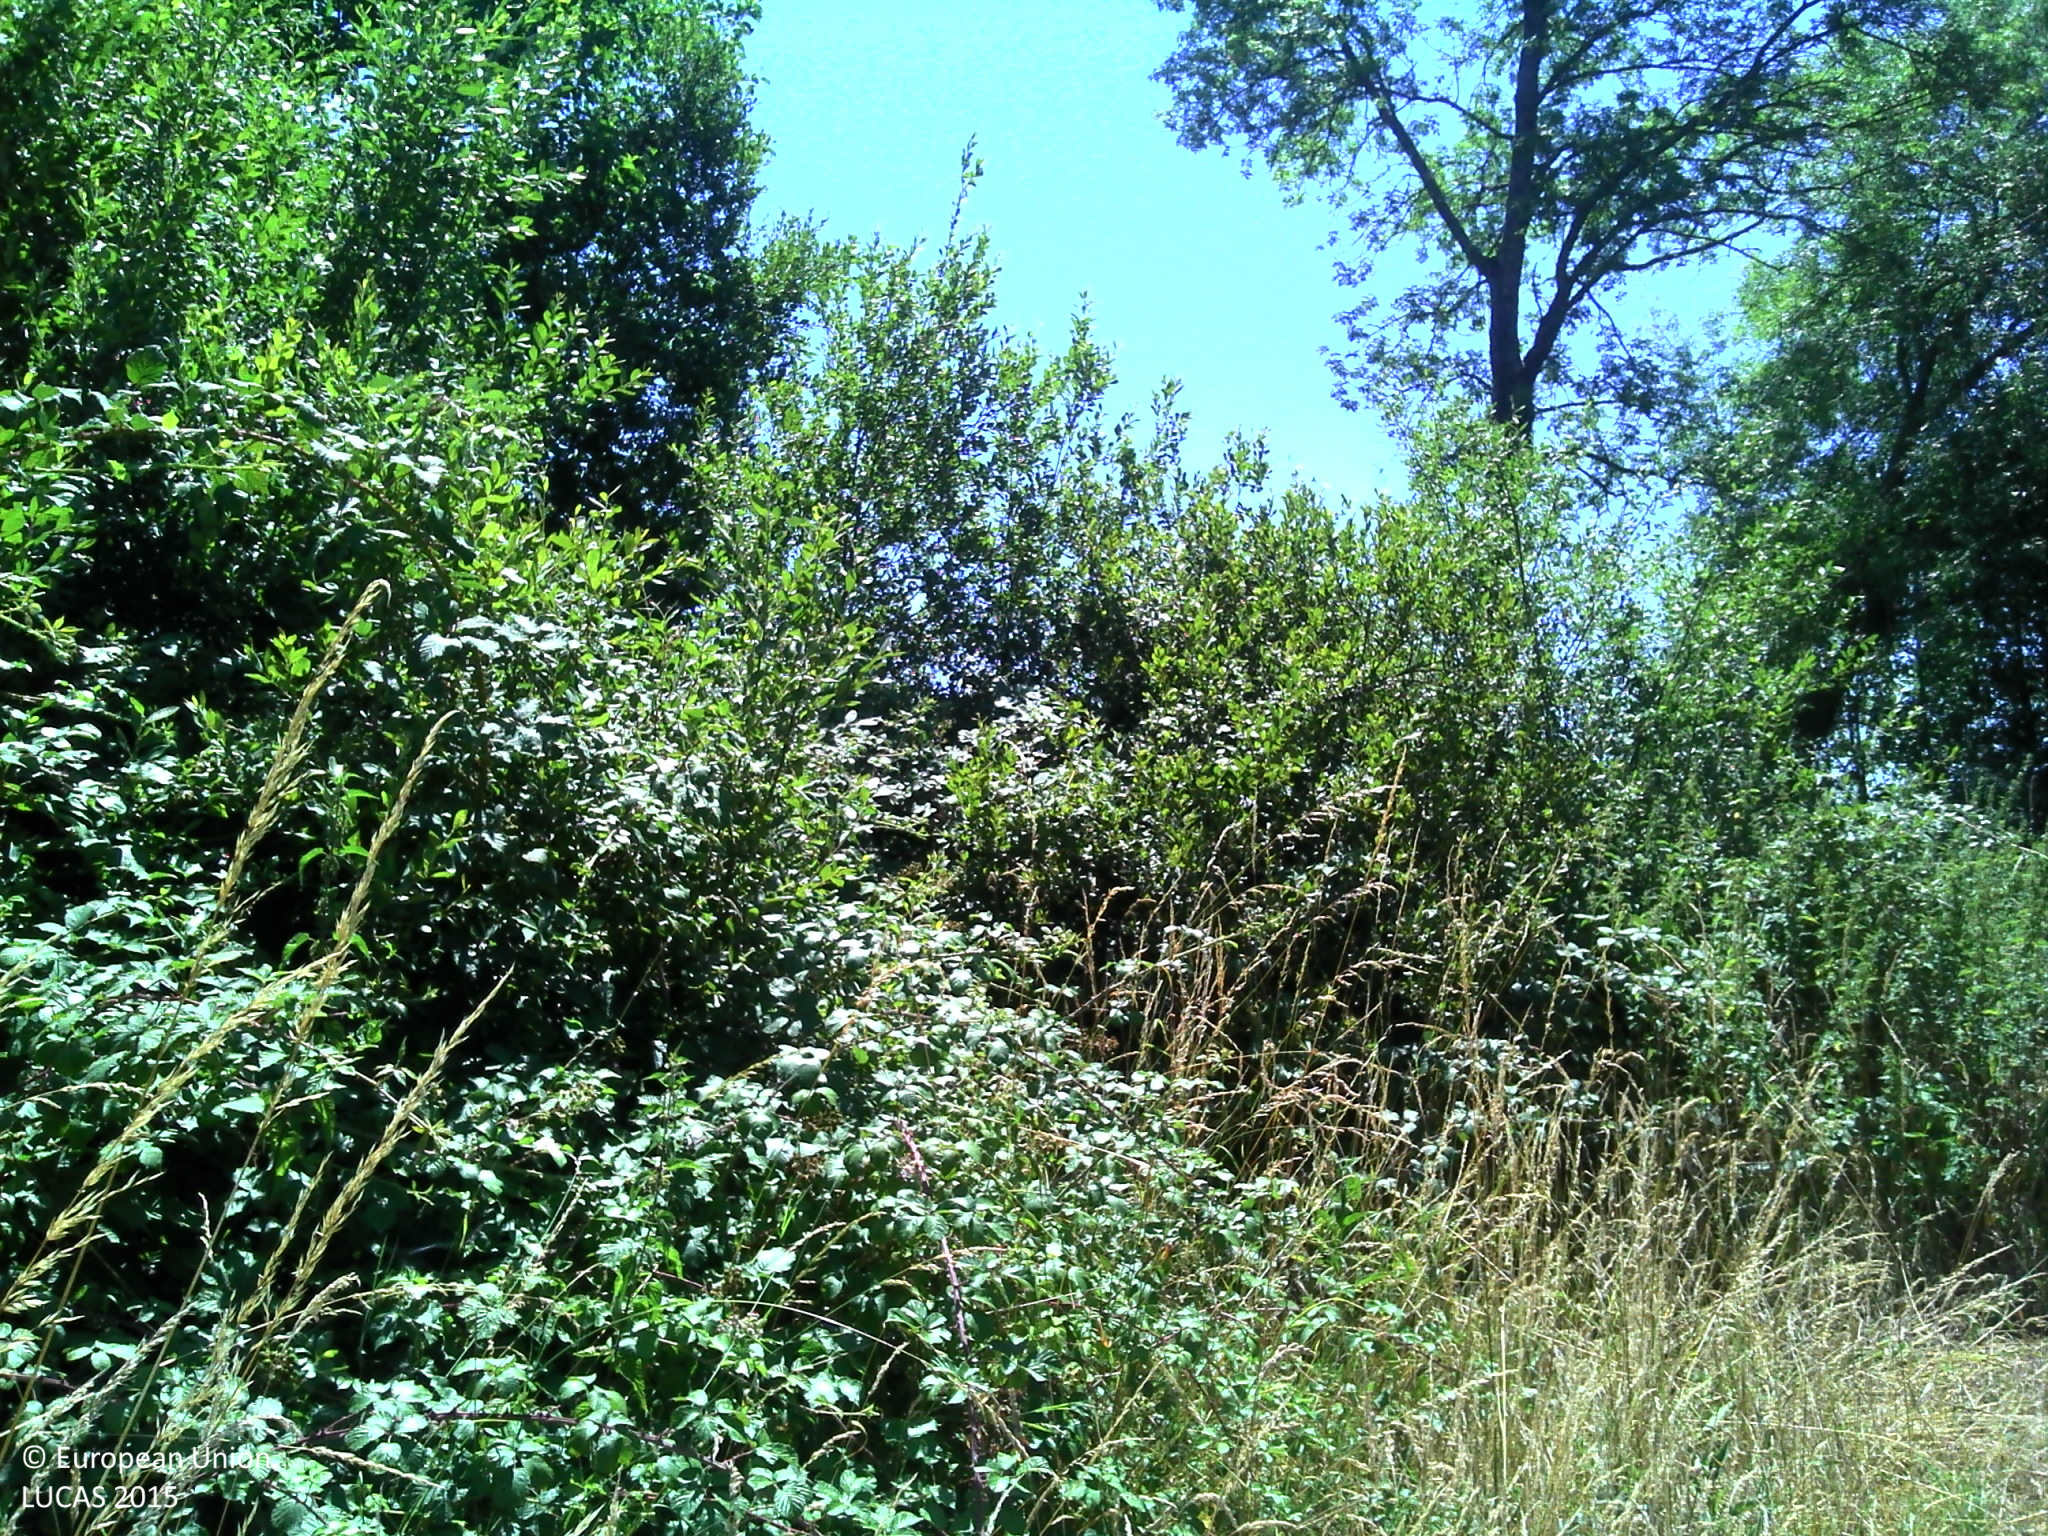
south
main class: Grassland
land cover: Grassland without tree/shrub cover
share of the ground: > 75 %
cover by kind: herbaceous plants 95 %, shrubs 5 %
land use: Agriculture (excluding fallow land and kitchen gardens)
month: July
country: FR
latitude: 47.6829
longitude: 0.2644
